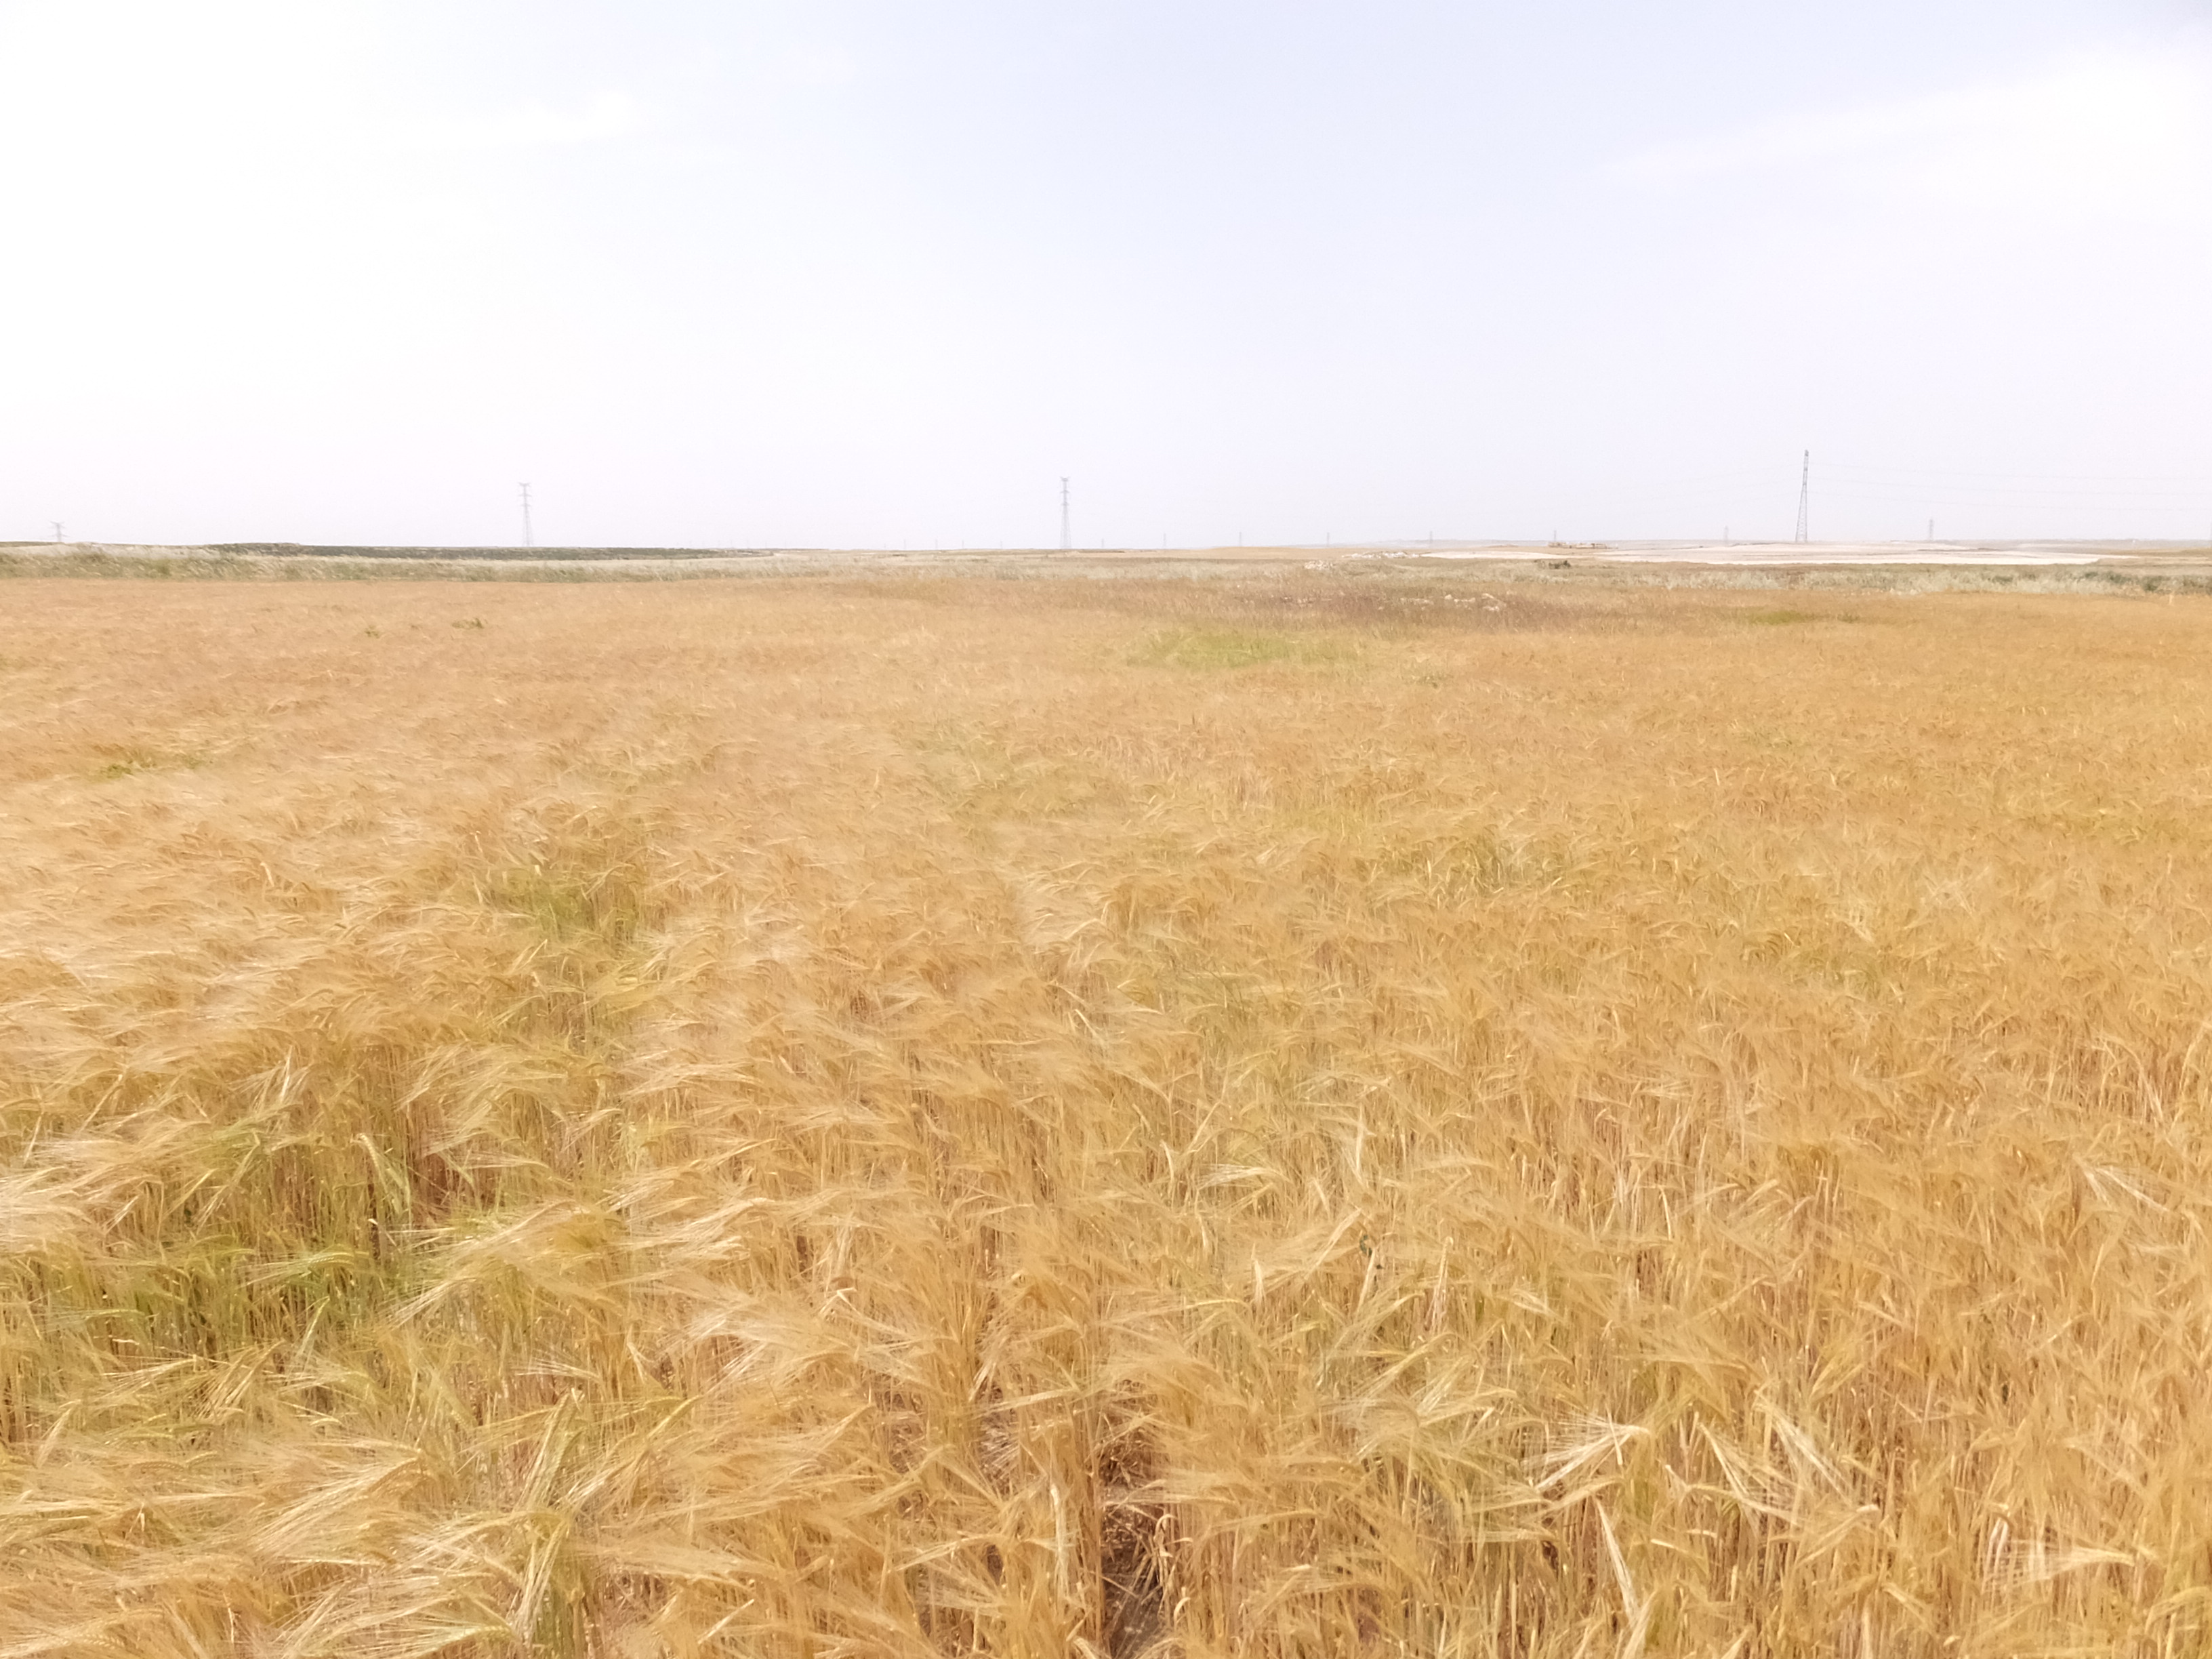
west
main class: Cropland
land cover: Barley
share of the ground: > 75 %
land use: Agriculture (excluding fallow land and kitchen gardens)
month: May
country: ES
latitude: 41.4177
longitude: -0.1245
